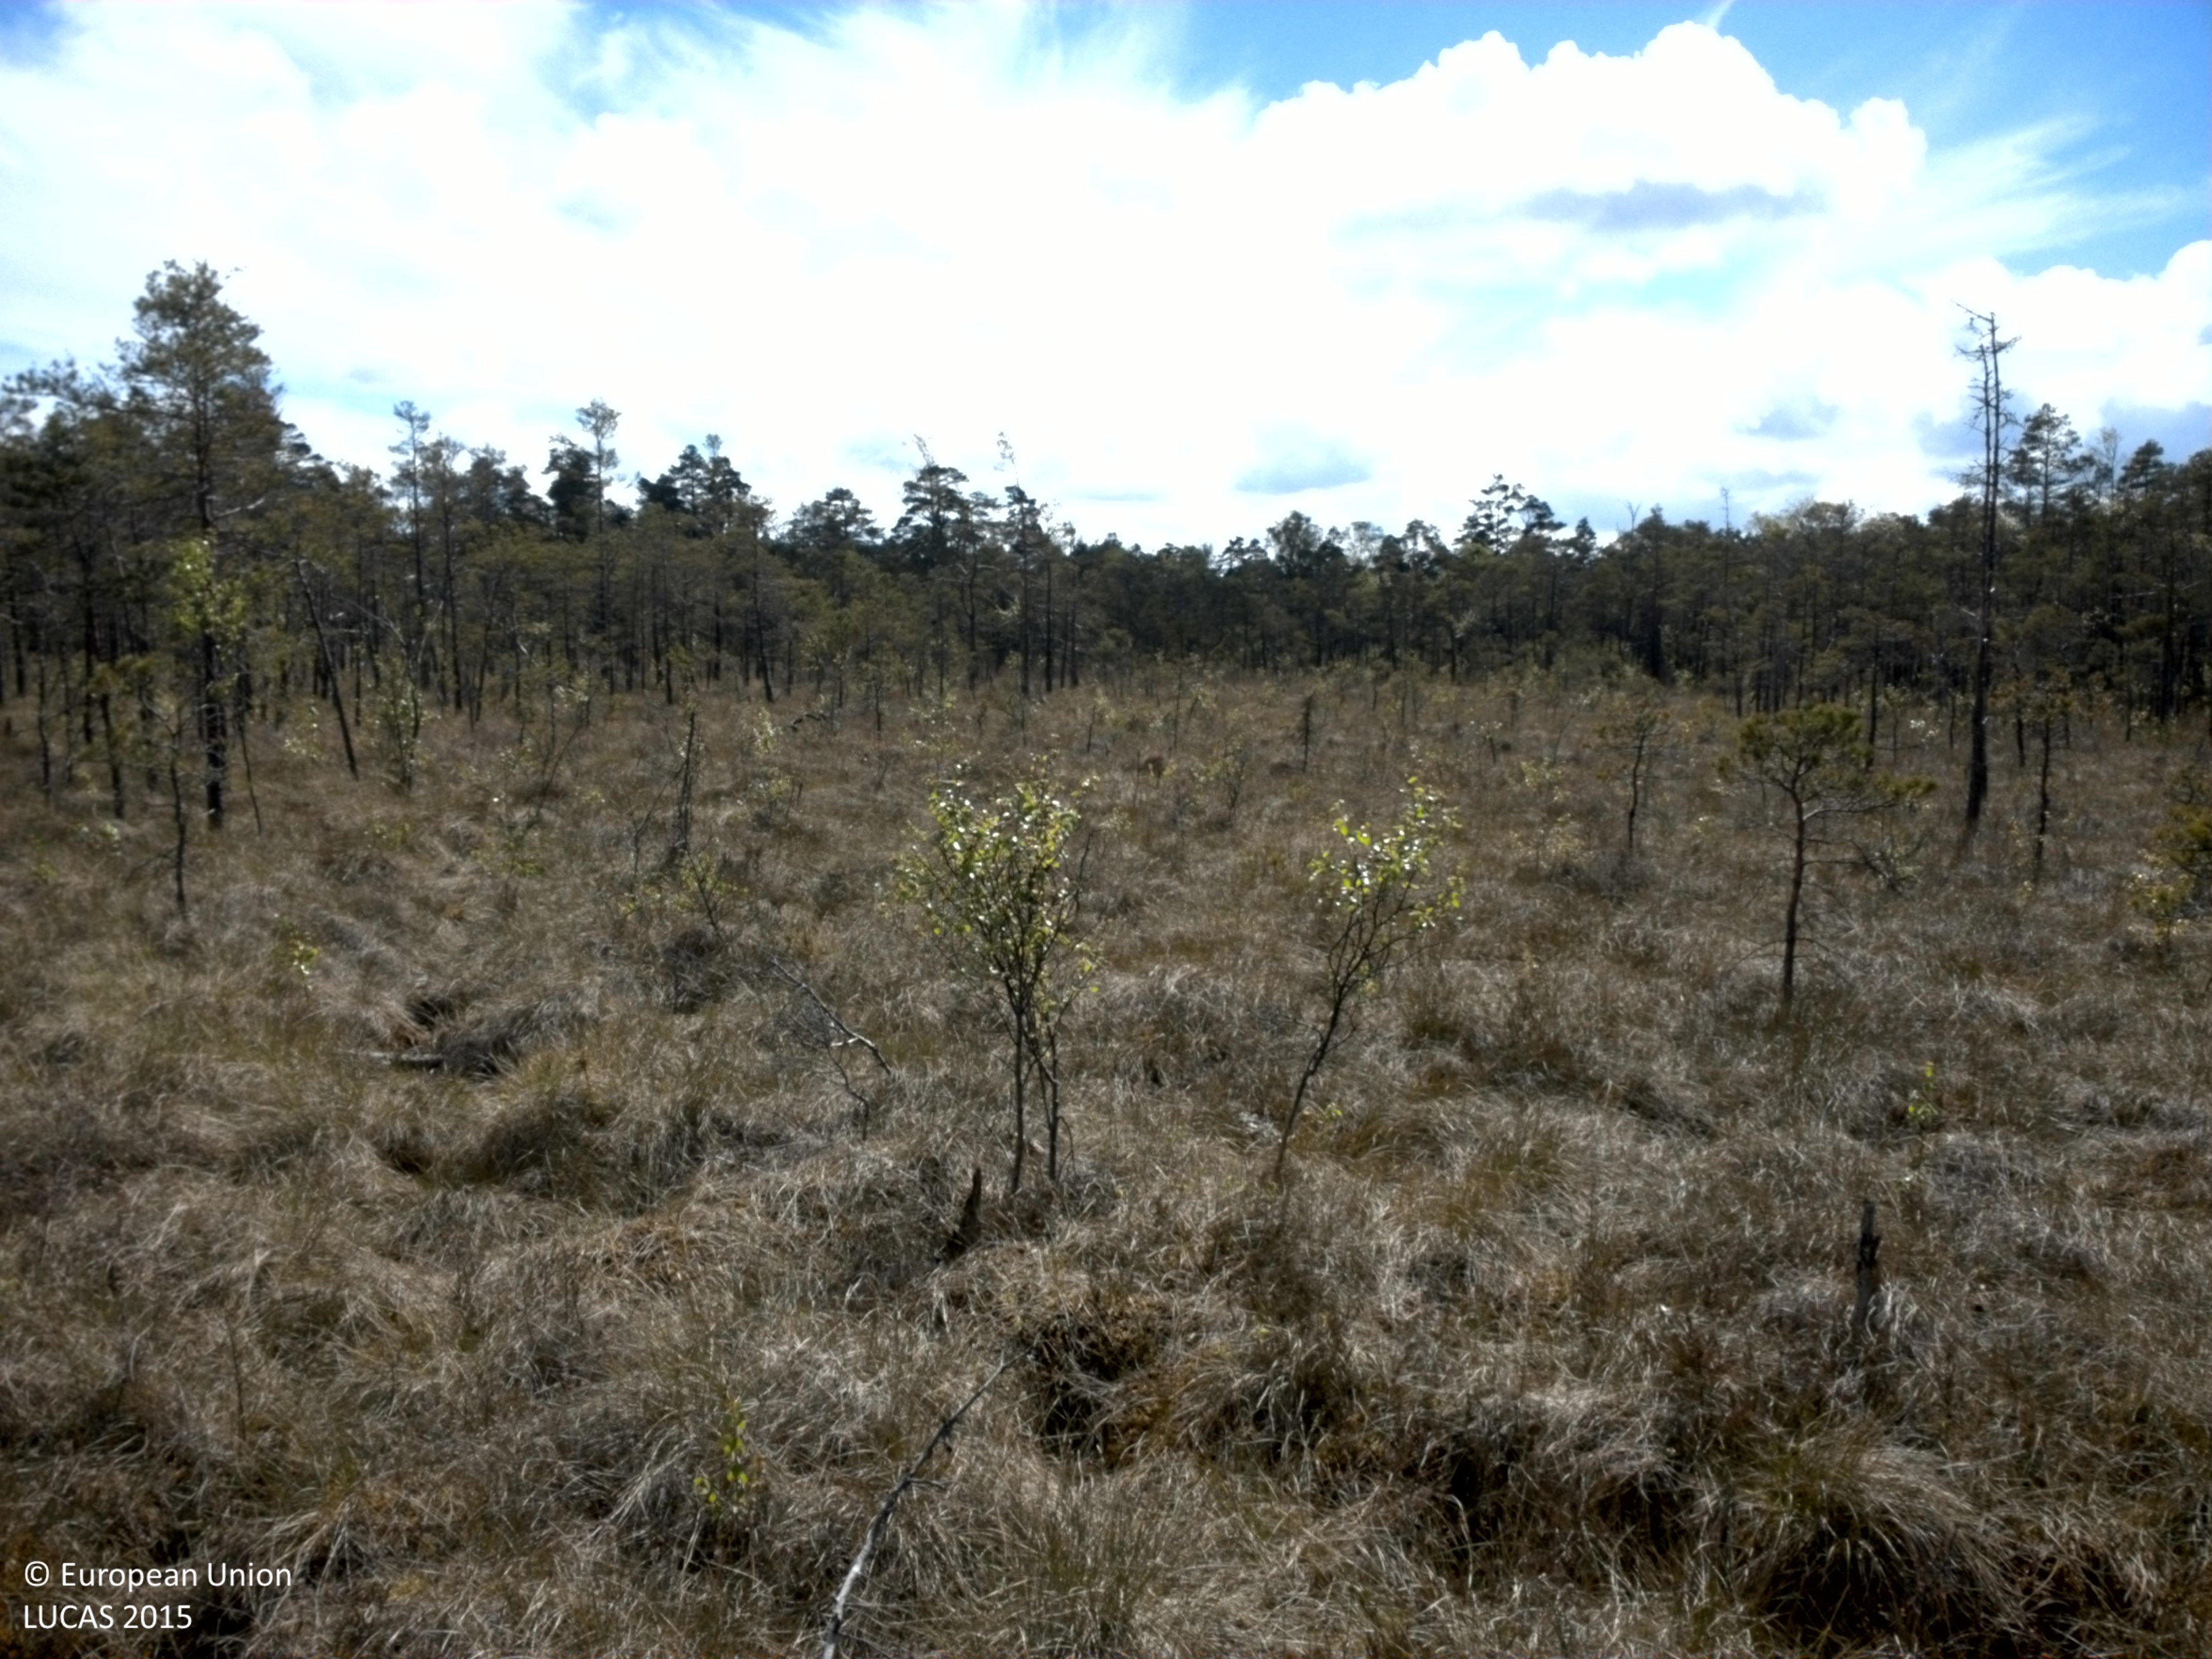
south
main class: Woodland
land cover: Pine dominated coniferous woodland
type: mire and swamp forests
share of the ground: 10 - 25 %
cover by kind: herbaceous plants 85 %, coniferous forest trees 15 %
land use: Amenities, museums, leisure
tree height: < 5 m
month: May
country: SE
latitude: 58.3808
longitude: 12.2359
